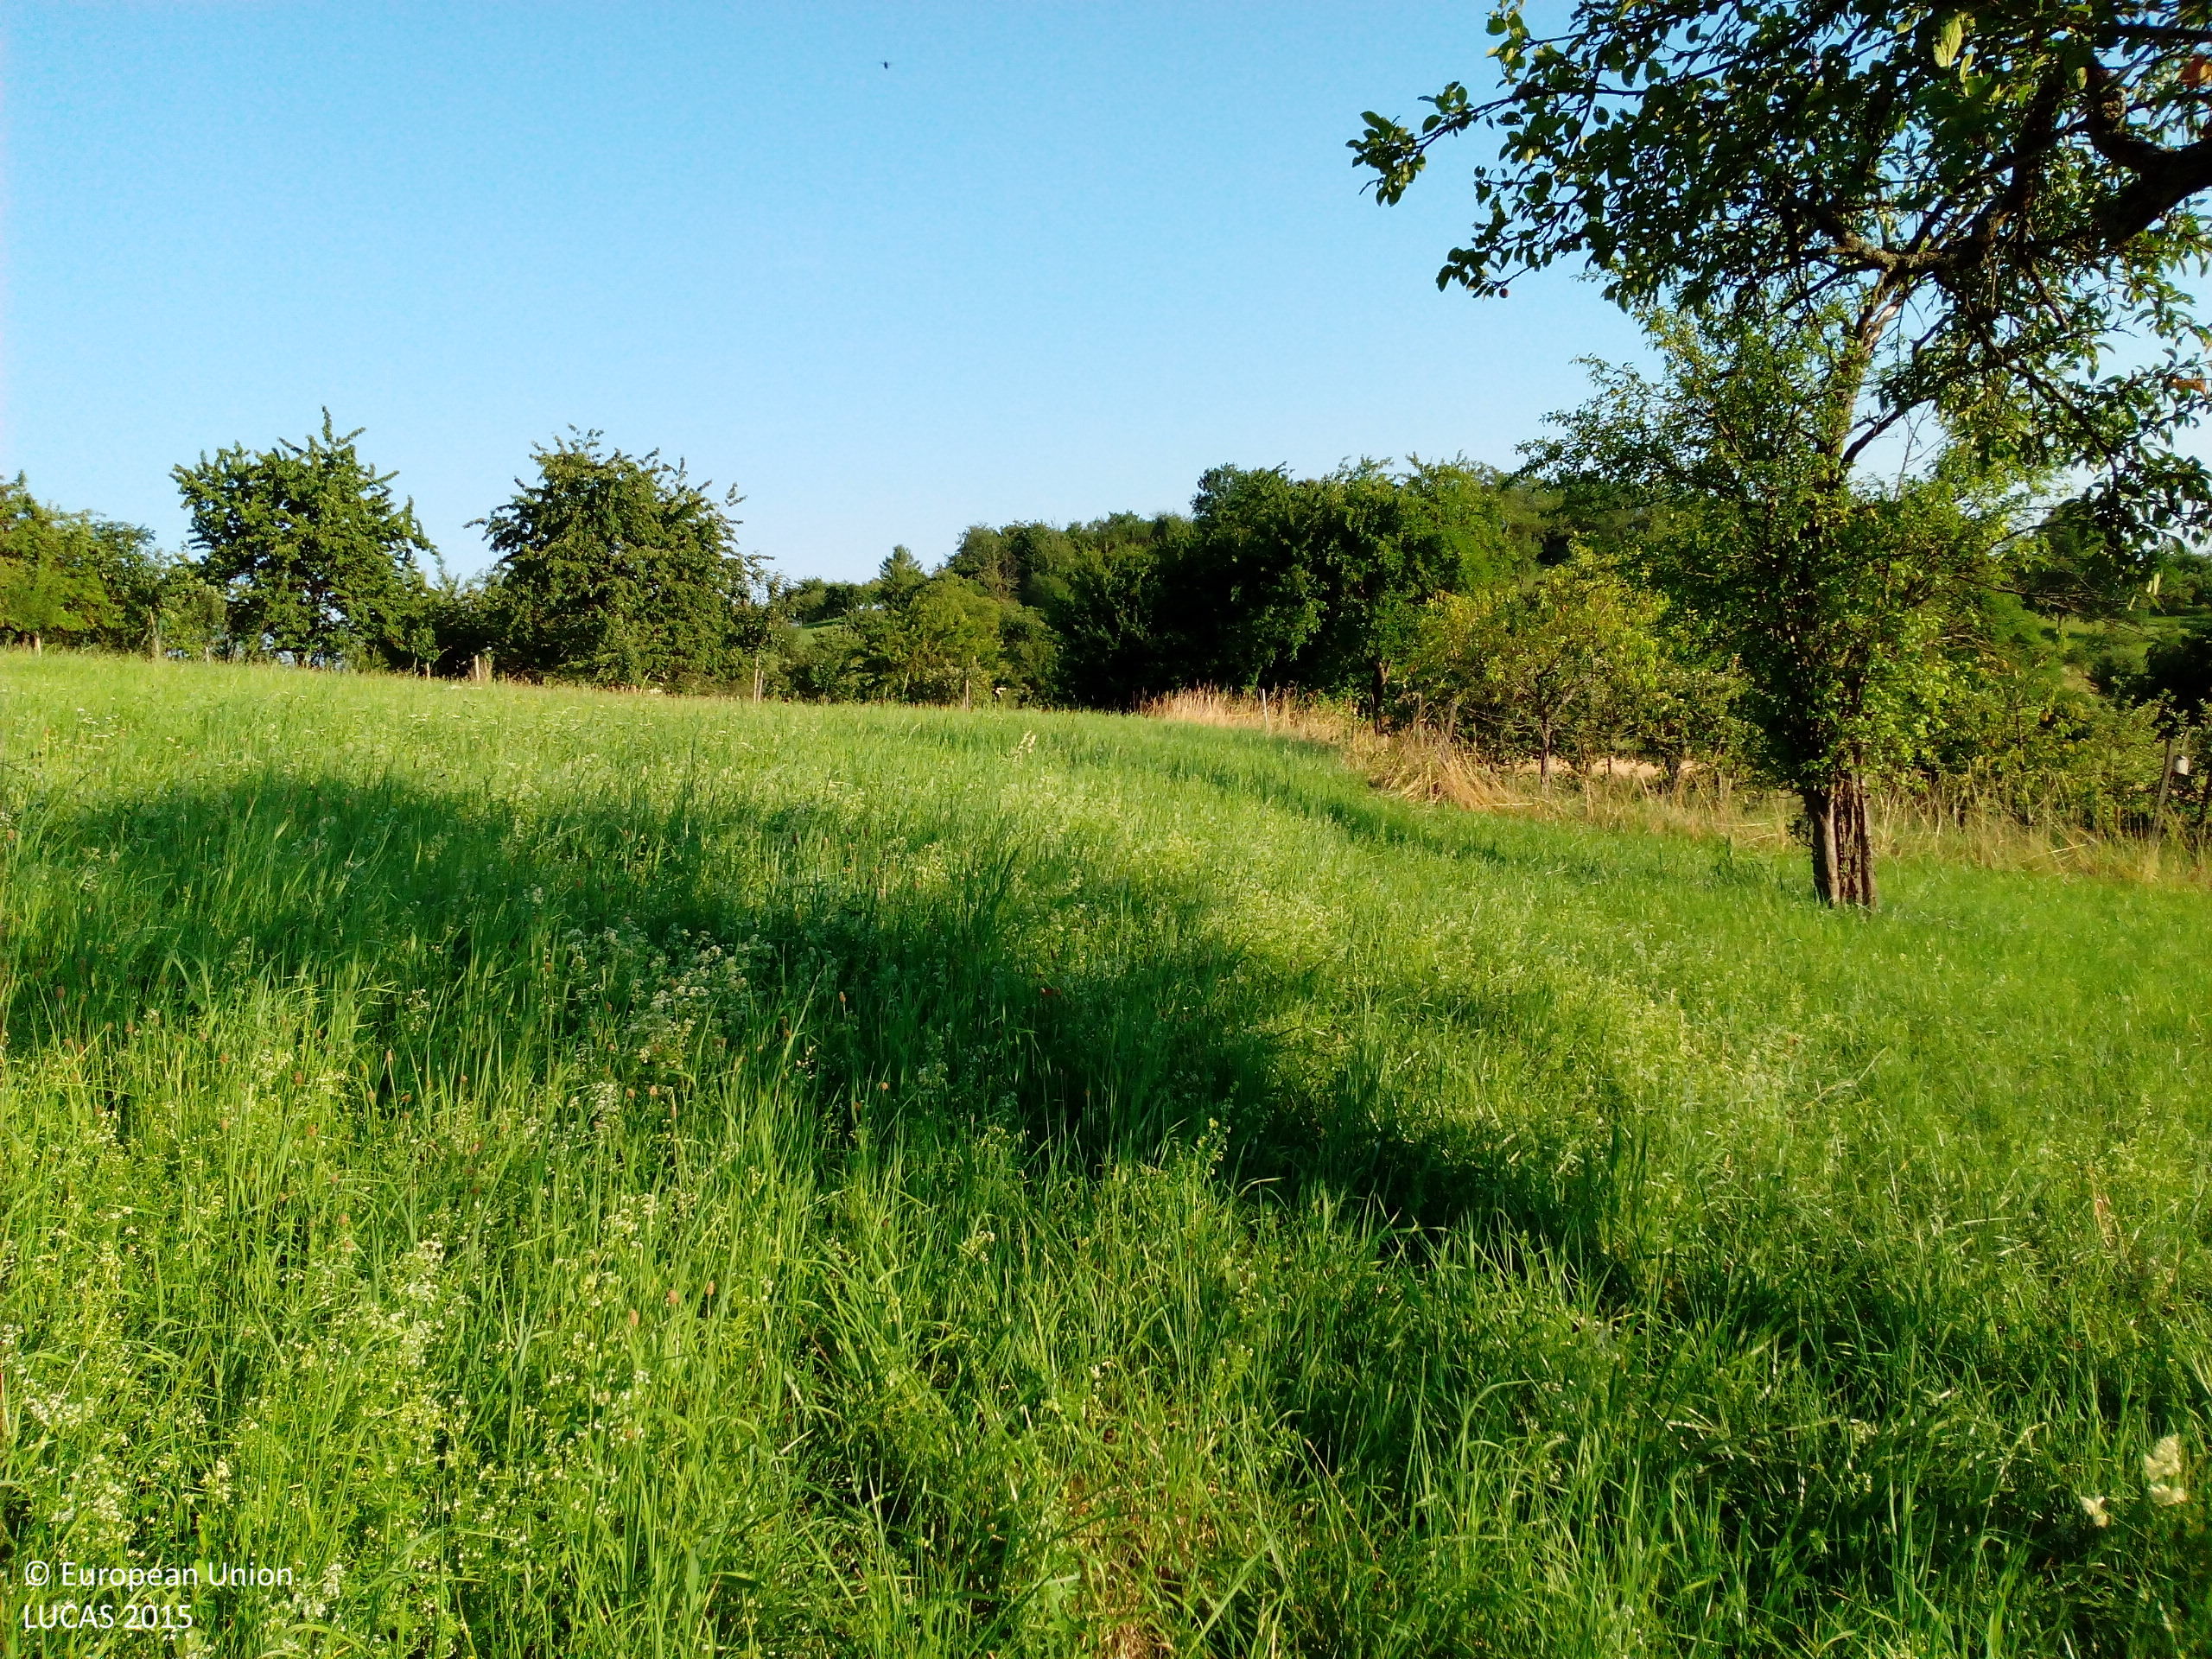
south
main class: Cropland
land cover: Other fruit trees and berries
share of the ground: < 10 %
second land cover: Grassland without tree/shrub cover
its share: > 75 %
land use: Agriculture (excluding fallow land and kitchen gardens)
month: July
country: DE
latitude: 47.7116
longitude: 7.6156
